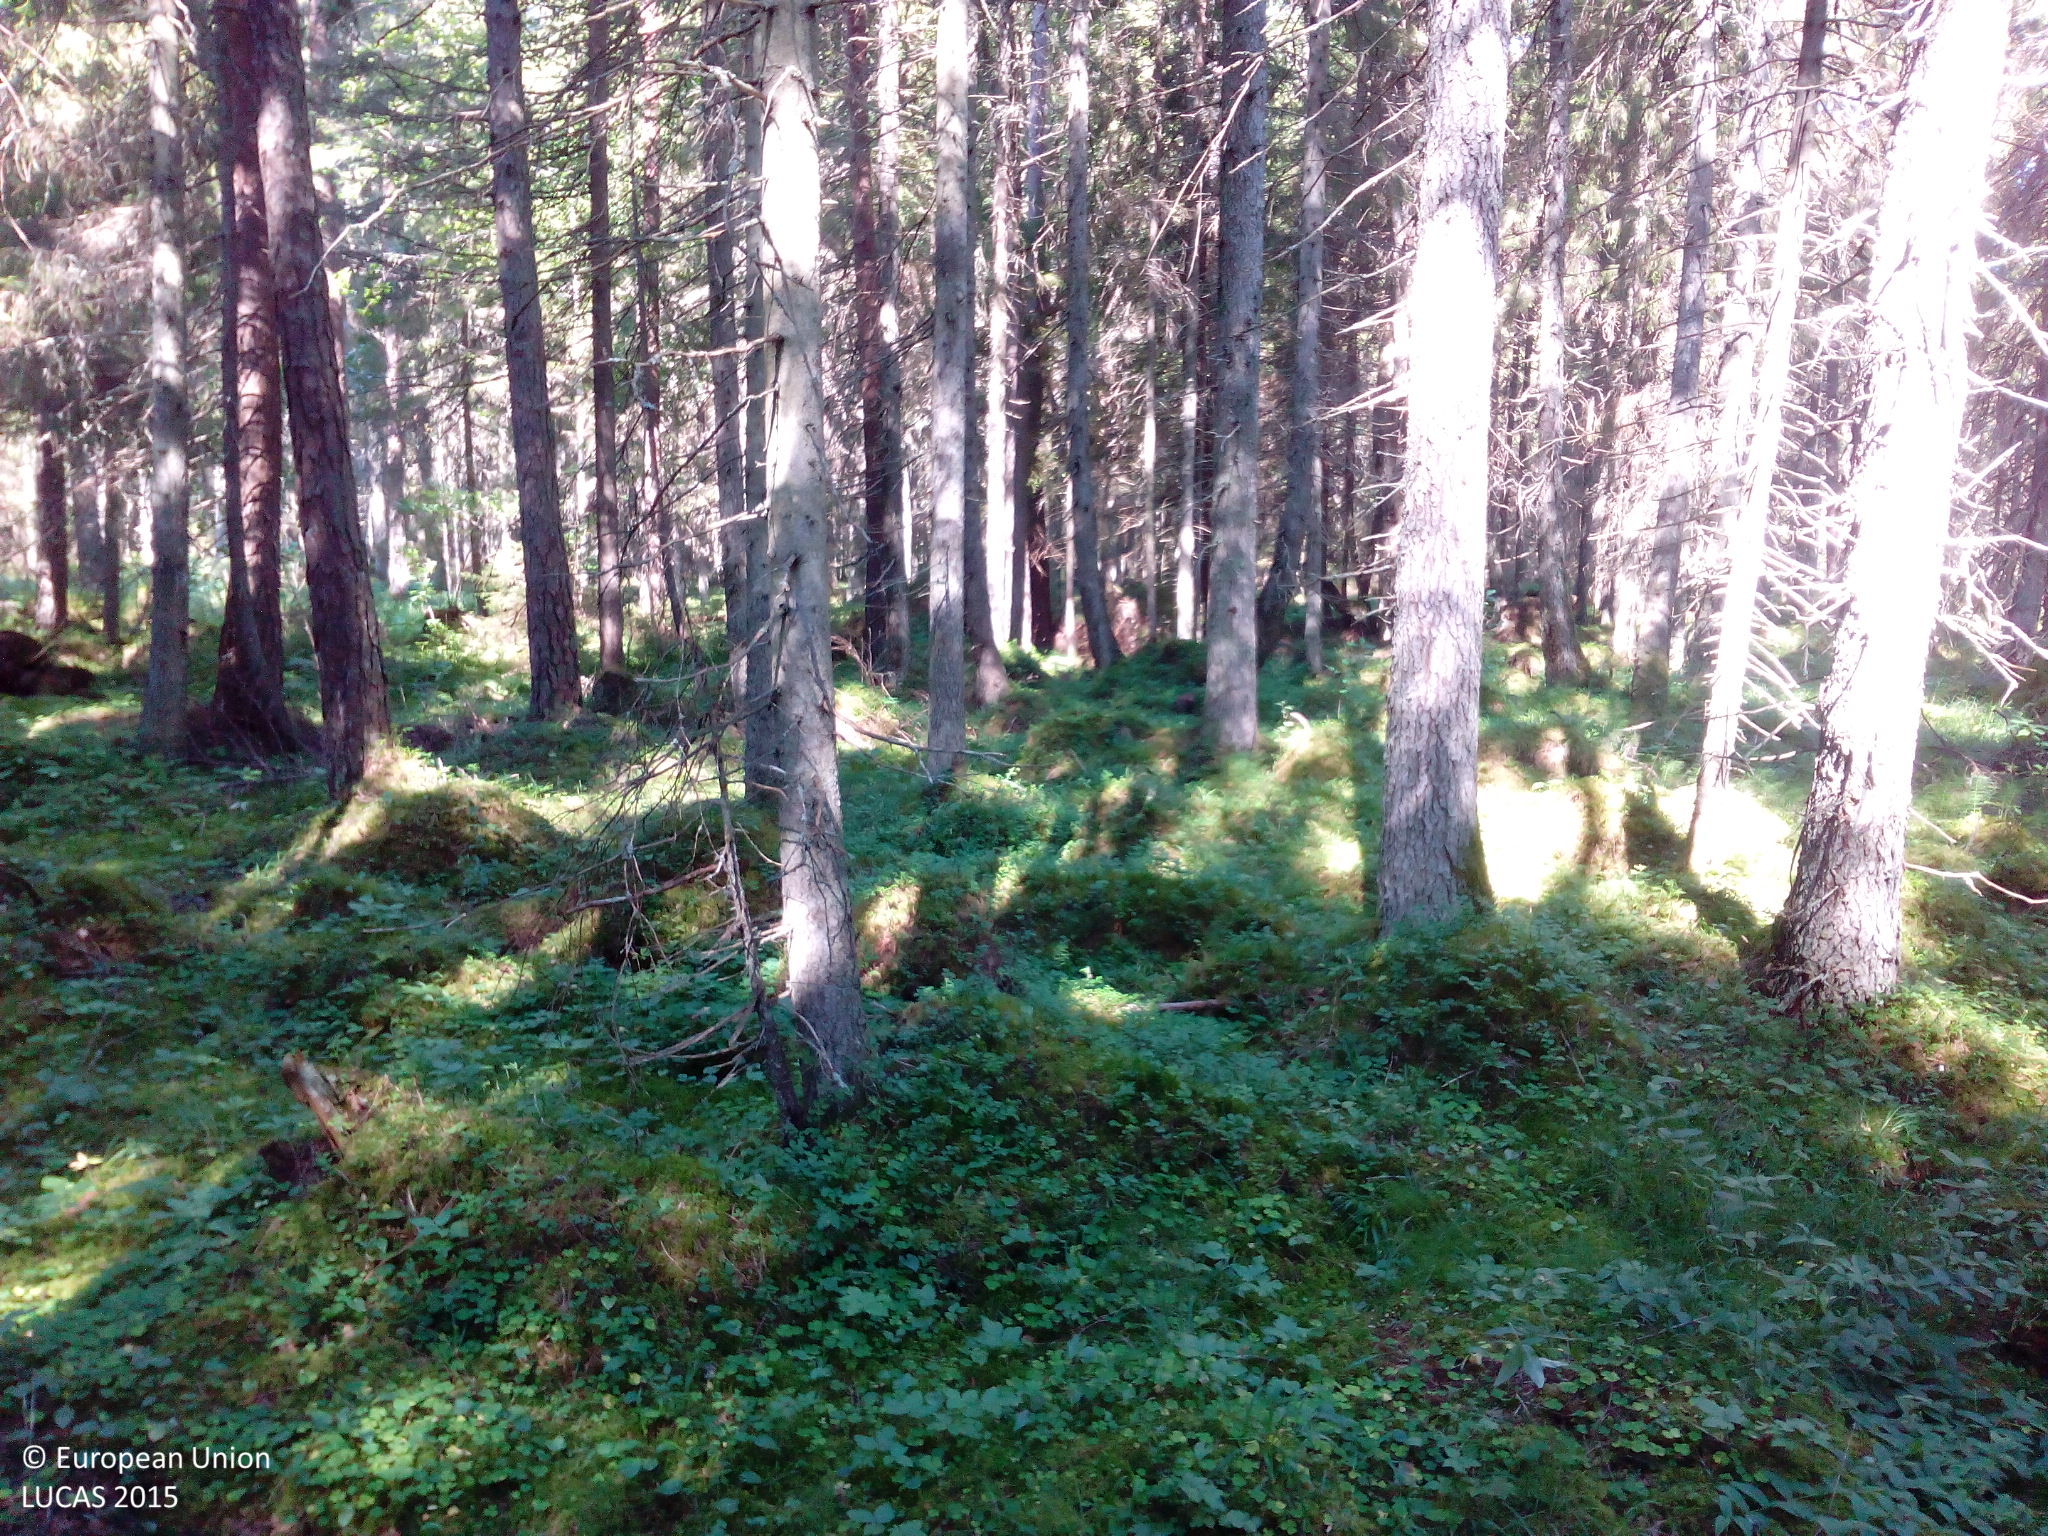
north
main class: Woodland
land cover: Spruce dominated coniferous woodland
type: hemiboreal forest and nemoral coniferous forest and mixed broadleaved-coniferous forest
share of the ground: > 75 %
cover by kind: coniferous forest trees 90 %, herbaceous plants 5 %, lichens and mosses 5 %
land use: Forestry
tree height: > 5 m
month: August
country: FI
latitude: 60.1410
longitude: 19.8921
